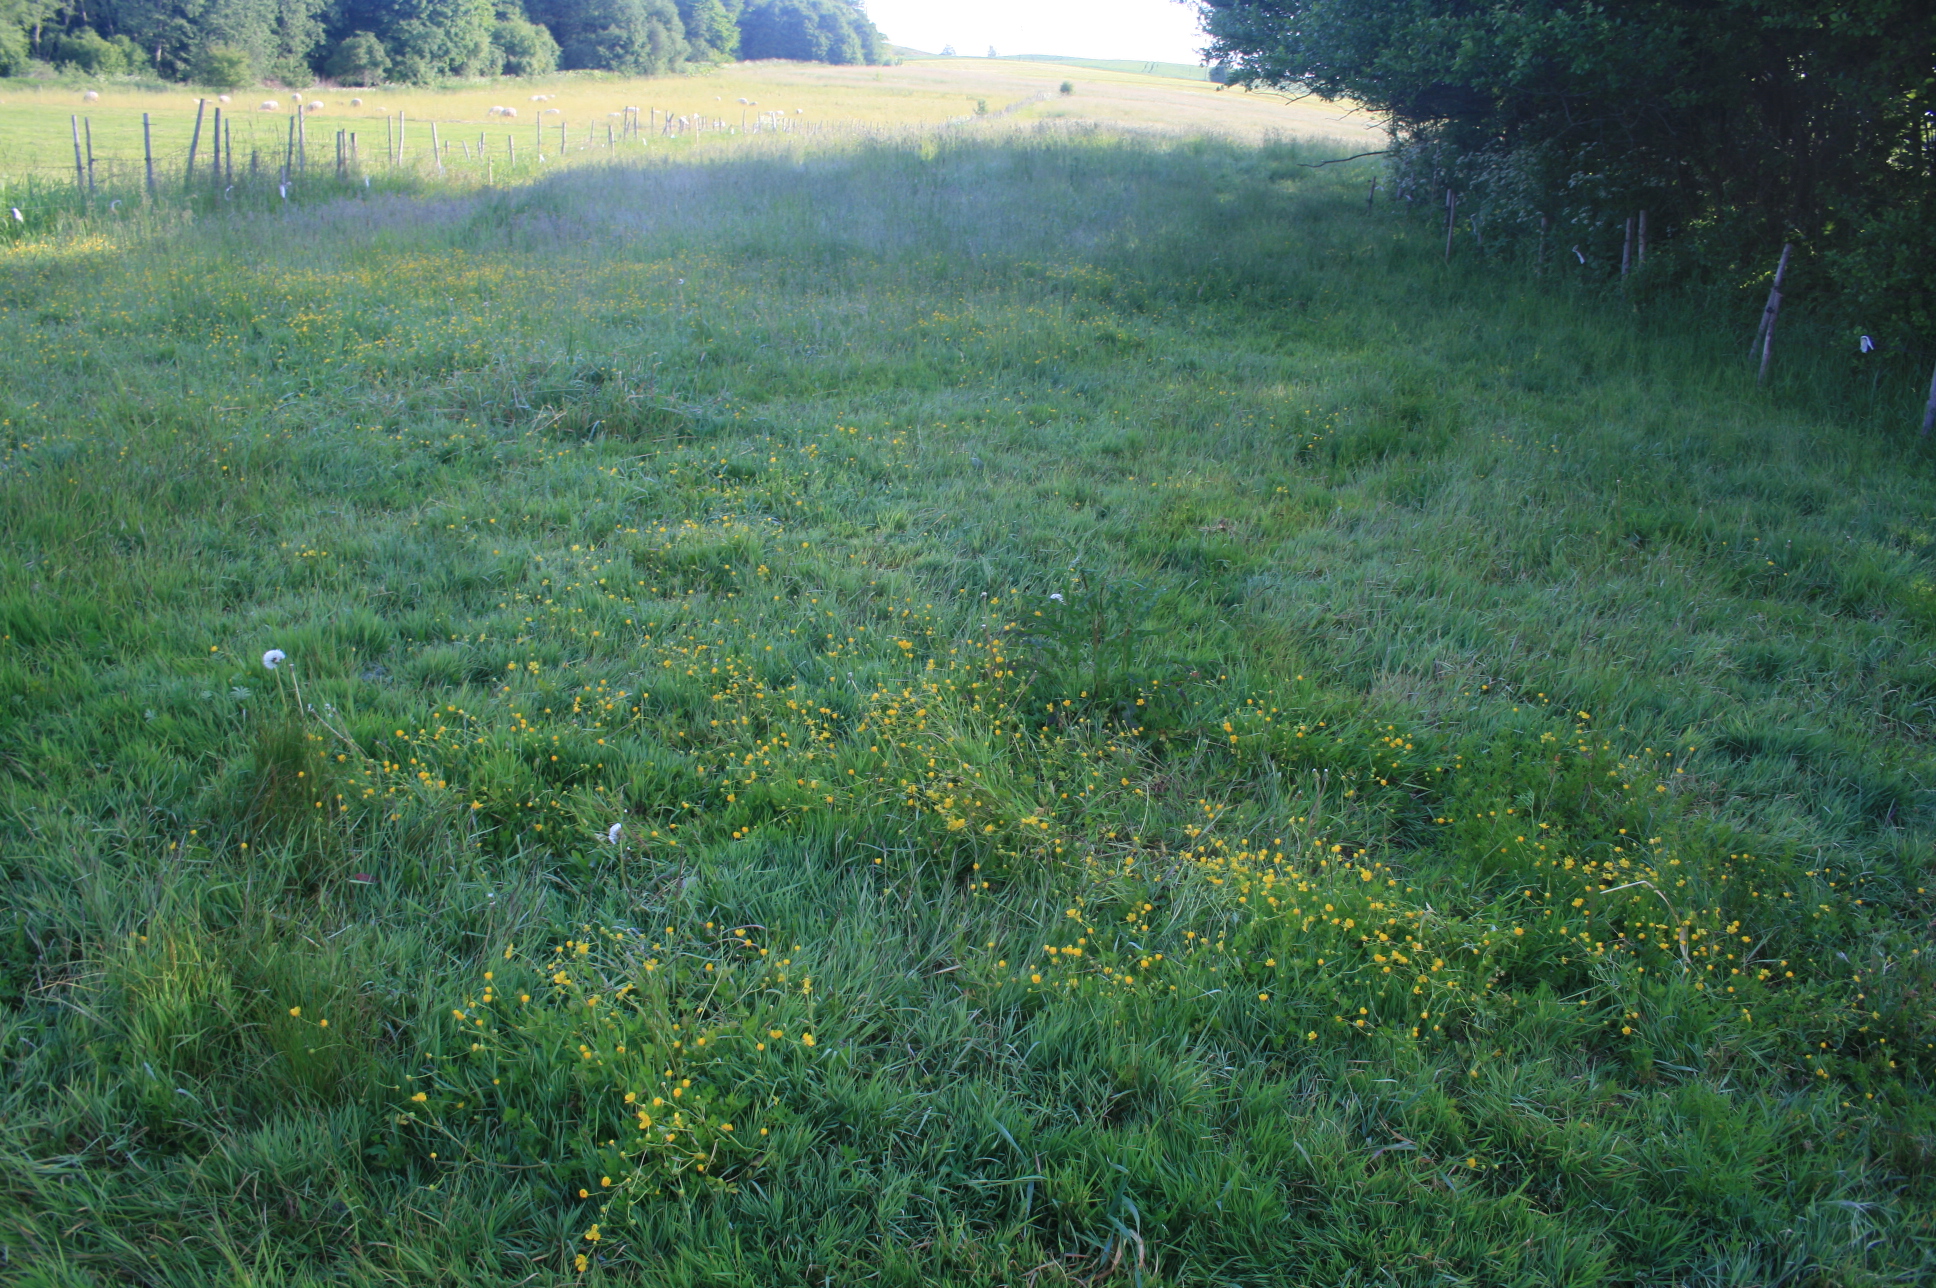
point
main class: Grassland
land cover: Grassland without tree/shrub cover
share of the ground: > 75 %
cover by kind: herbaceous plants 100 %
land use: Agriculture (excluding fallow land and kitchen gardens)
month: June
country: LT
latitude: 55.7360
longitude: 22.1424
